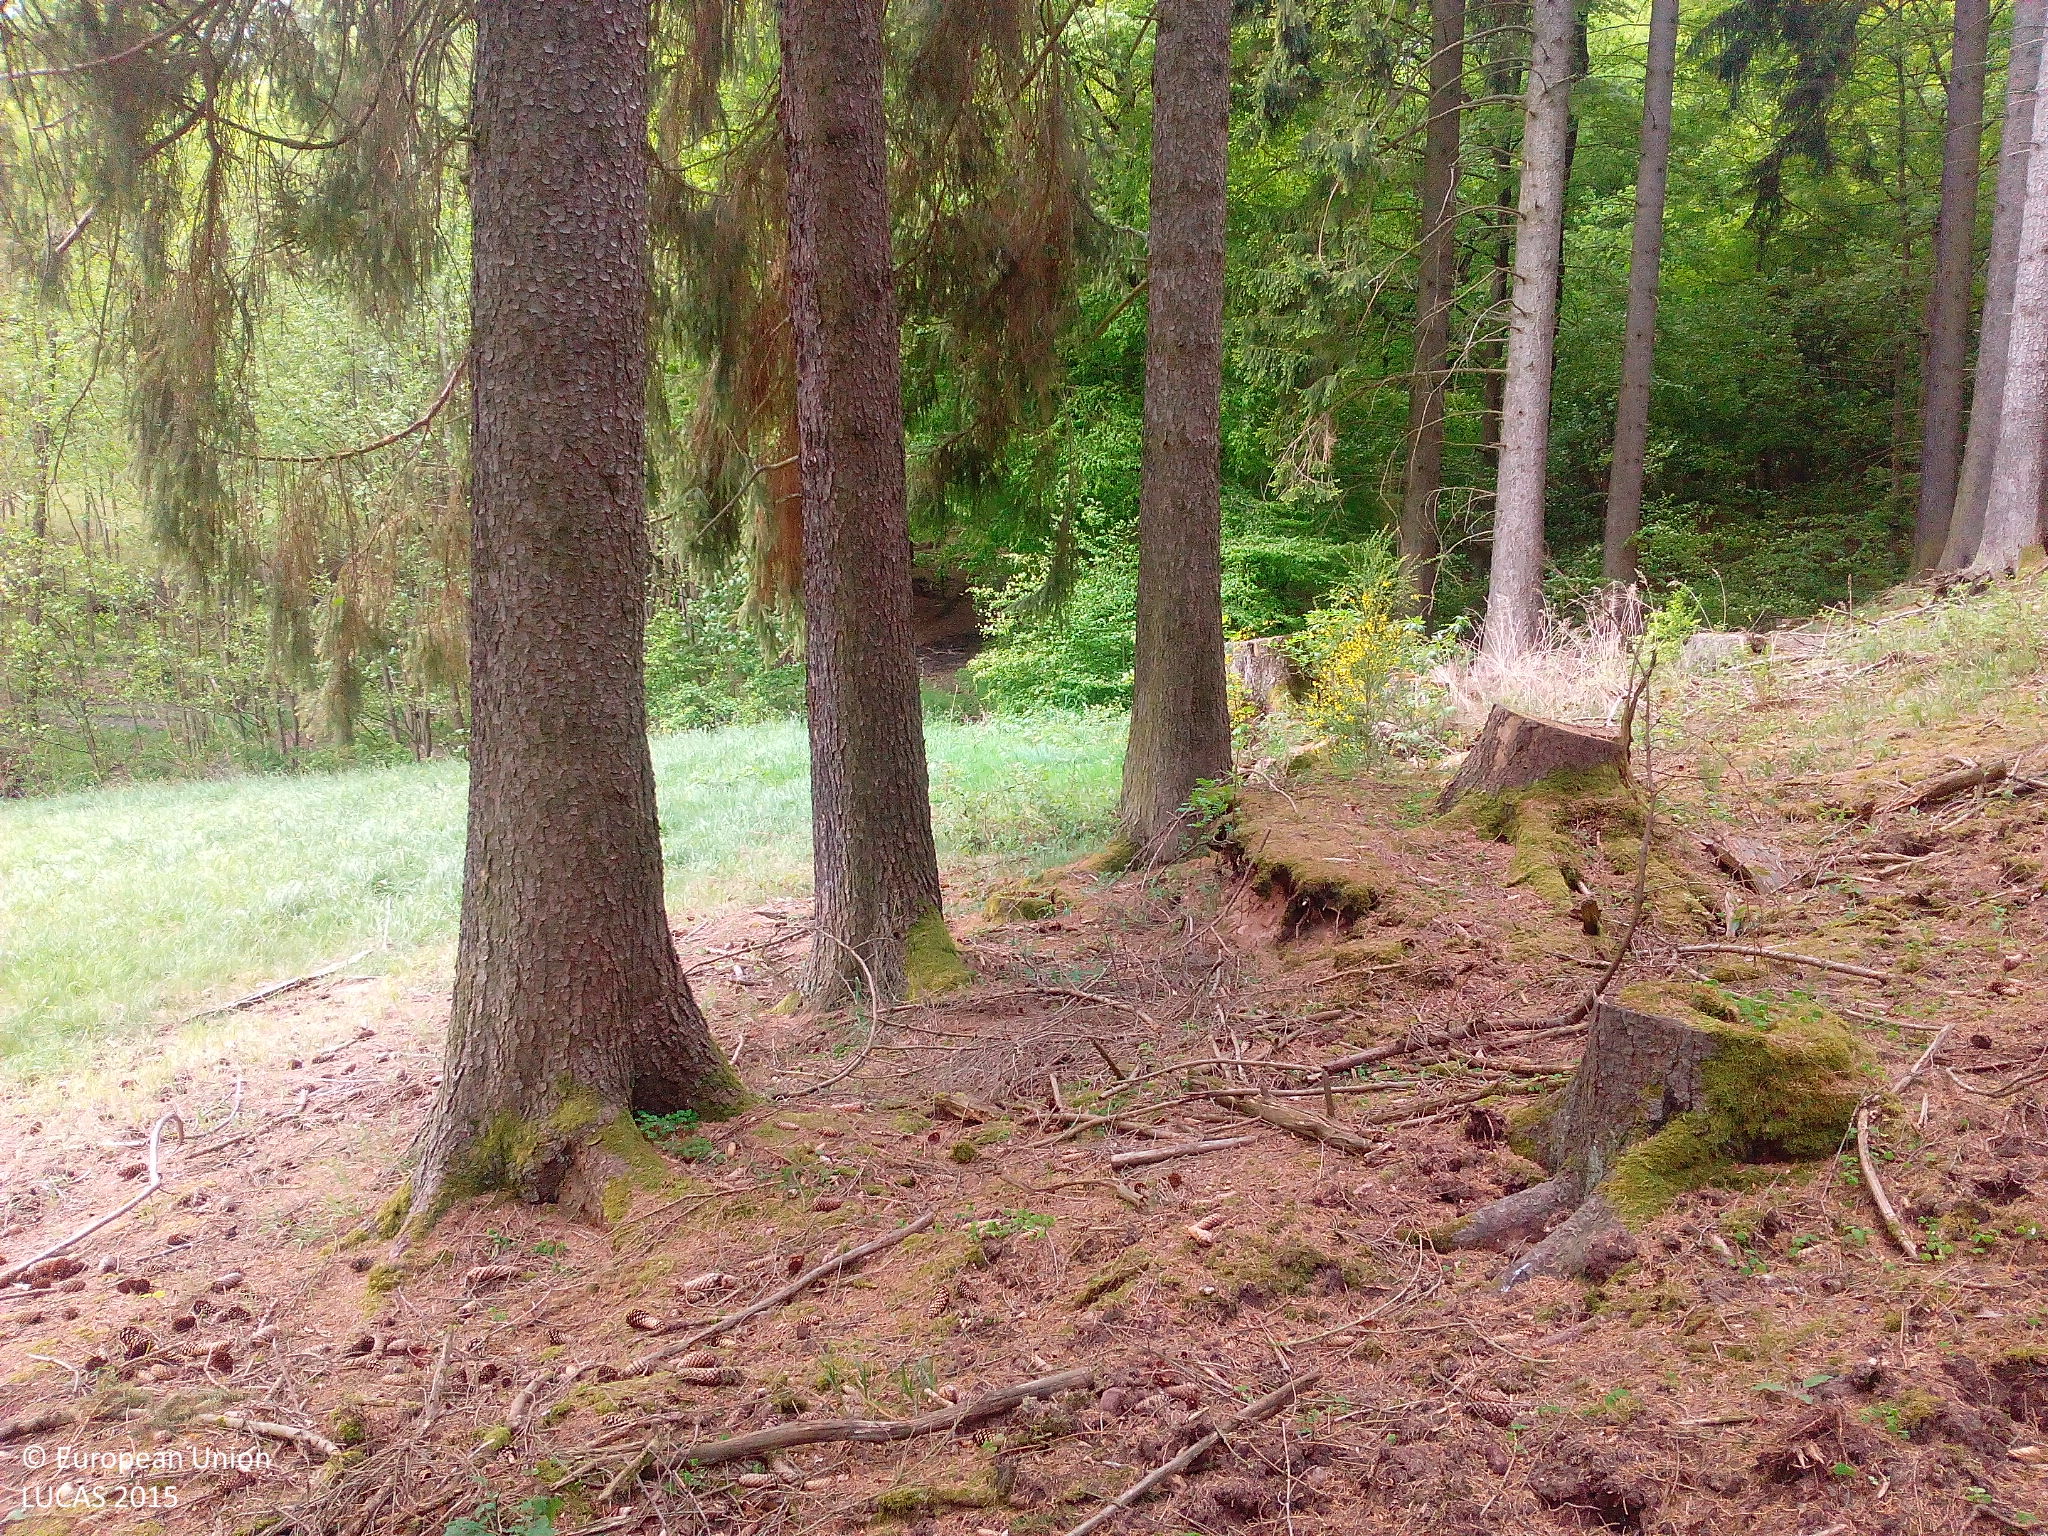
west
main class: Woodland
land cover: Spruce dominated coniferous woodland
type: hemiboreal forest and nemoral coniferous forest and mixed broadleaved-coniferous forest
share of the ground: > 75 %
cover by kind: coniferous forest trees 60 %, unconsolidated bare surface 35 %, lichens and mosses 5 %
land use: Forestry
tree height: > 5 m
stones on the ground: < 10 %
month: May
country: DE
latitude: 51.1910
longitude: 9.8713
